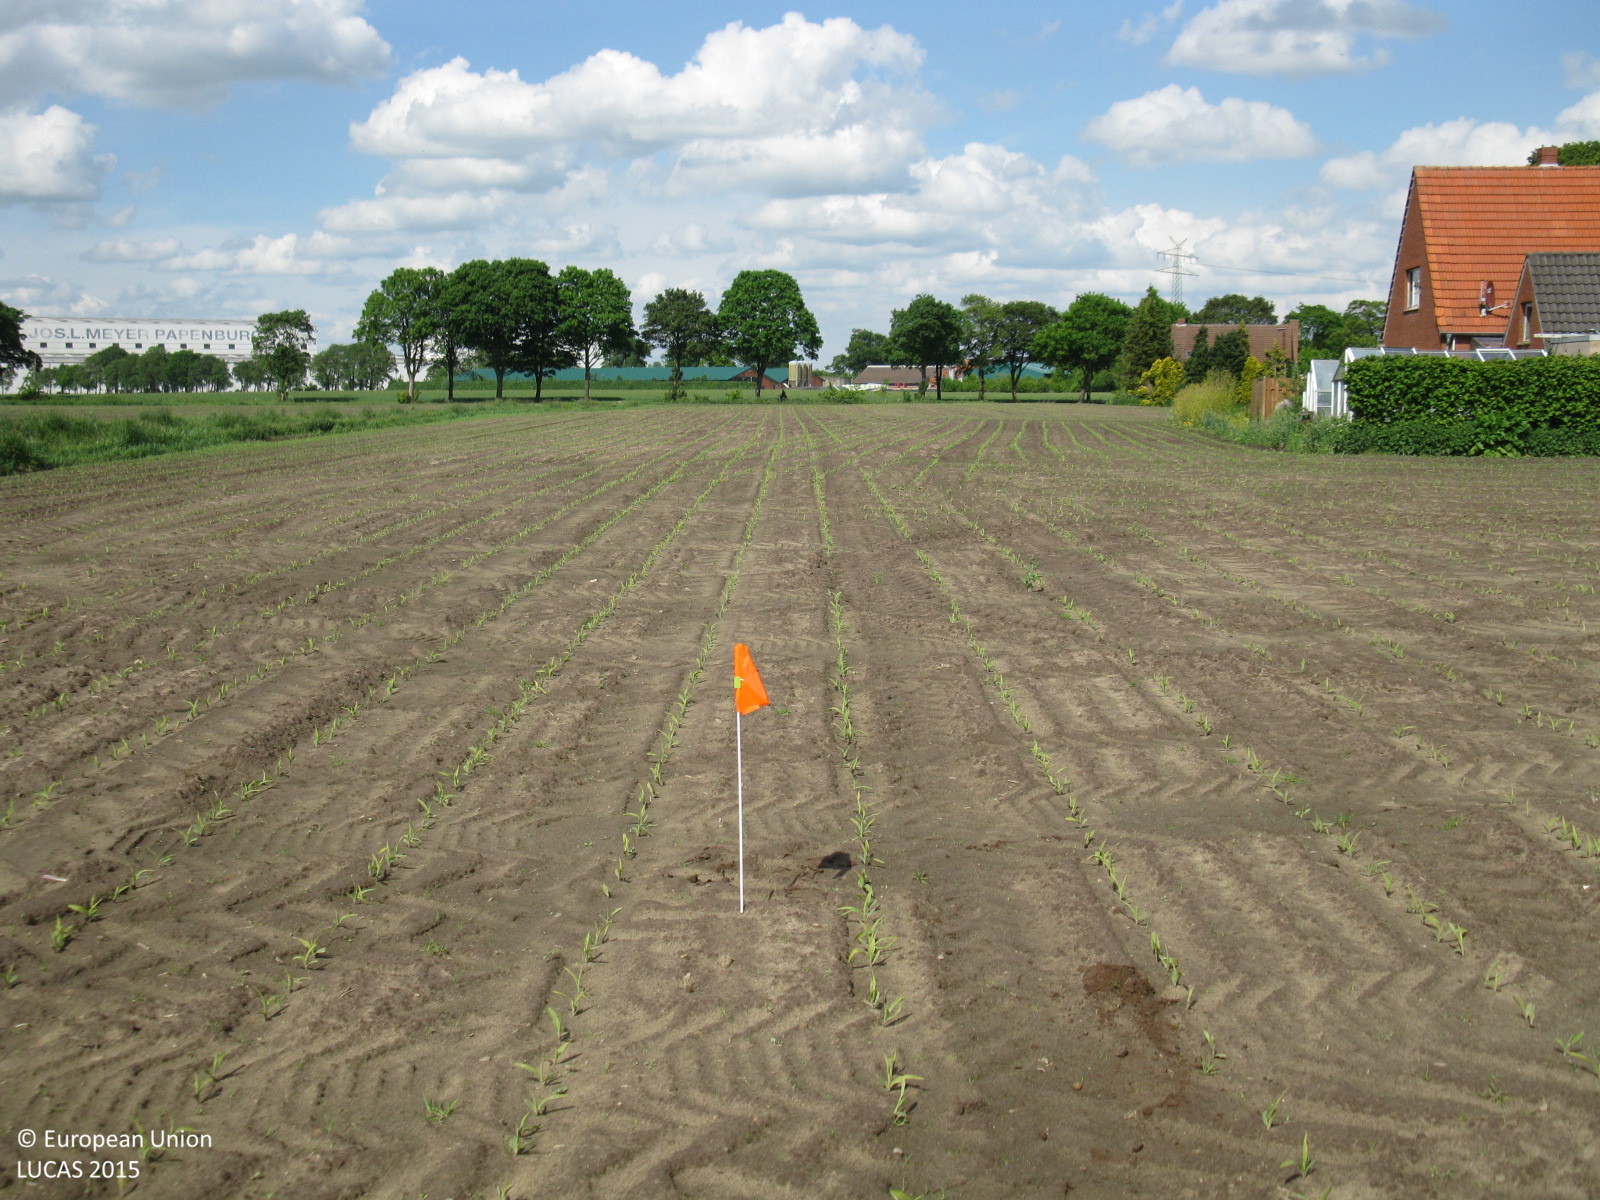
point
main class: Cropland
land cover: Maize
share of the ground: < 10 %
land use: Agriculture (excluding fallow land and kitchen gardens)
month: June
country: DE
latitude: 53.0854
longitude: 7.3579
